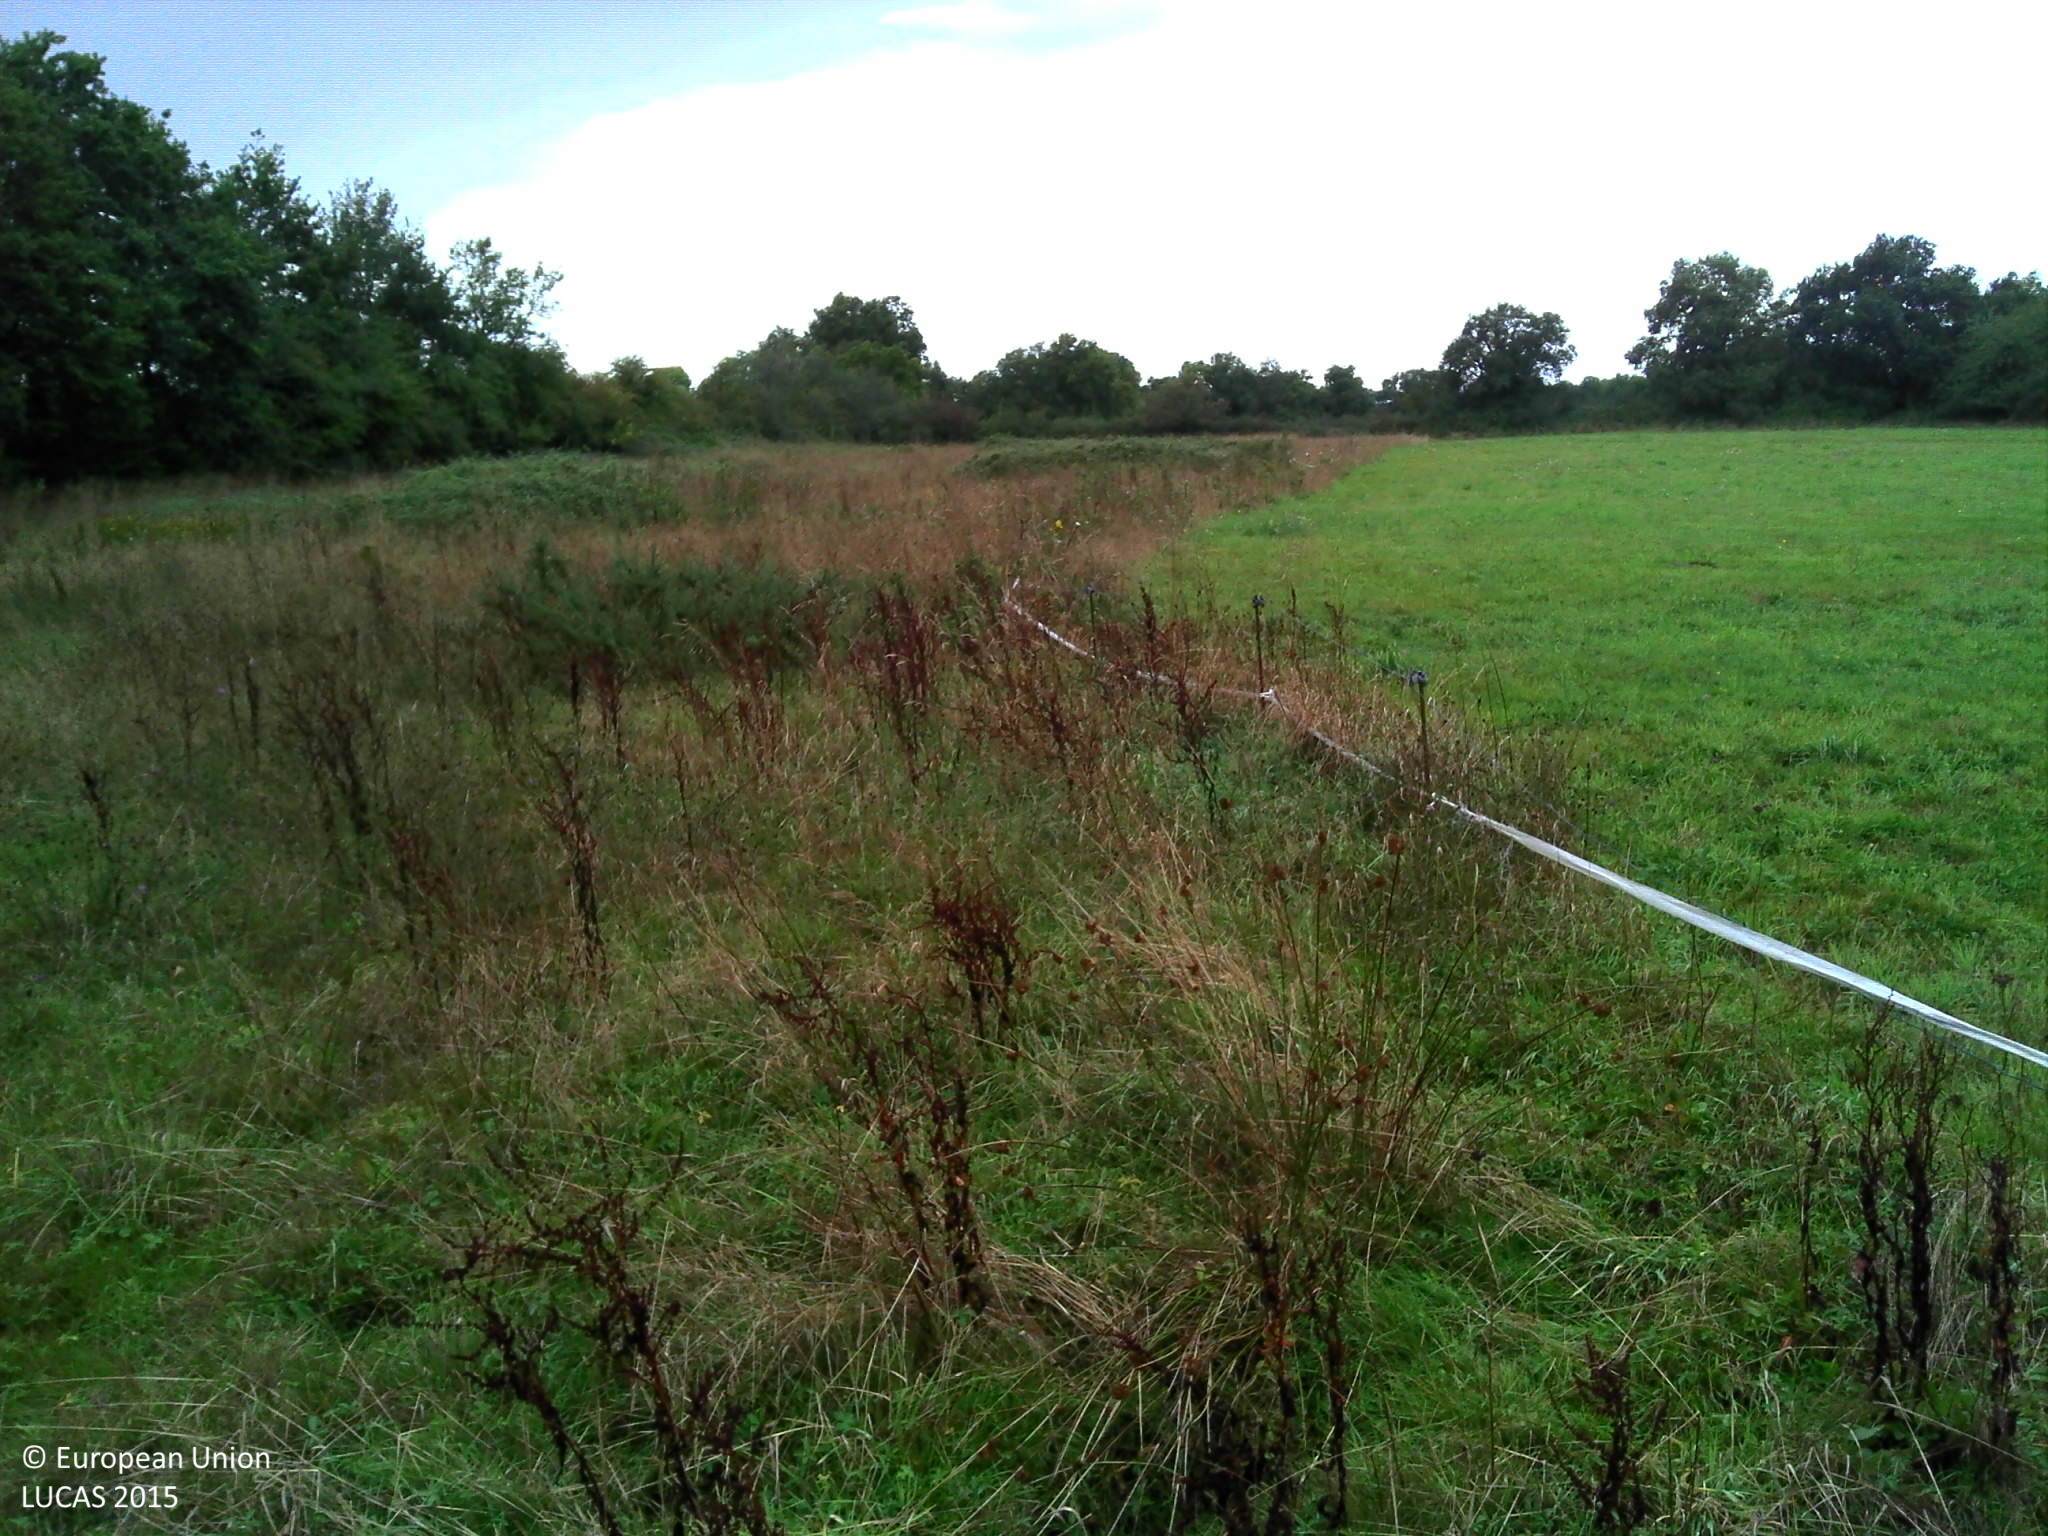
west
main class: Grassland
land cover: Grassland without tree/shrub cover
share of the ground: > 75 %
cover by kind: herbaceous plants 100 %
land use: Agriculture (excluding fallow land and kitchen gardens)
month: September
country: FR
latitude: 46.6412
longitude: 1.6684
